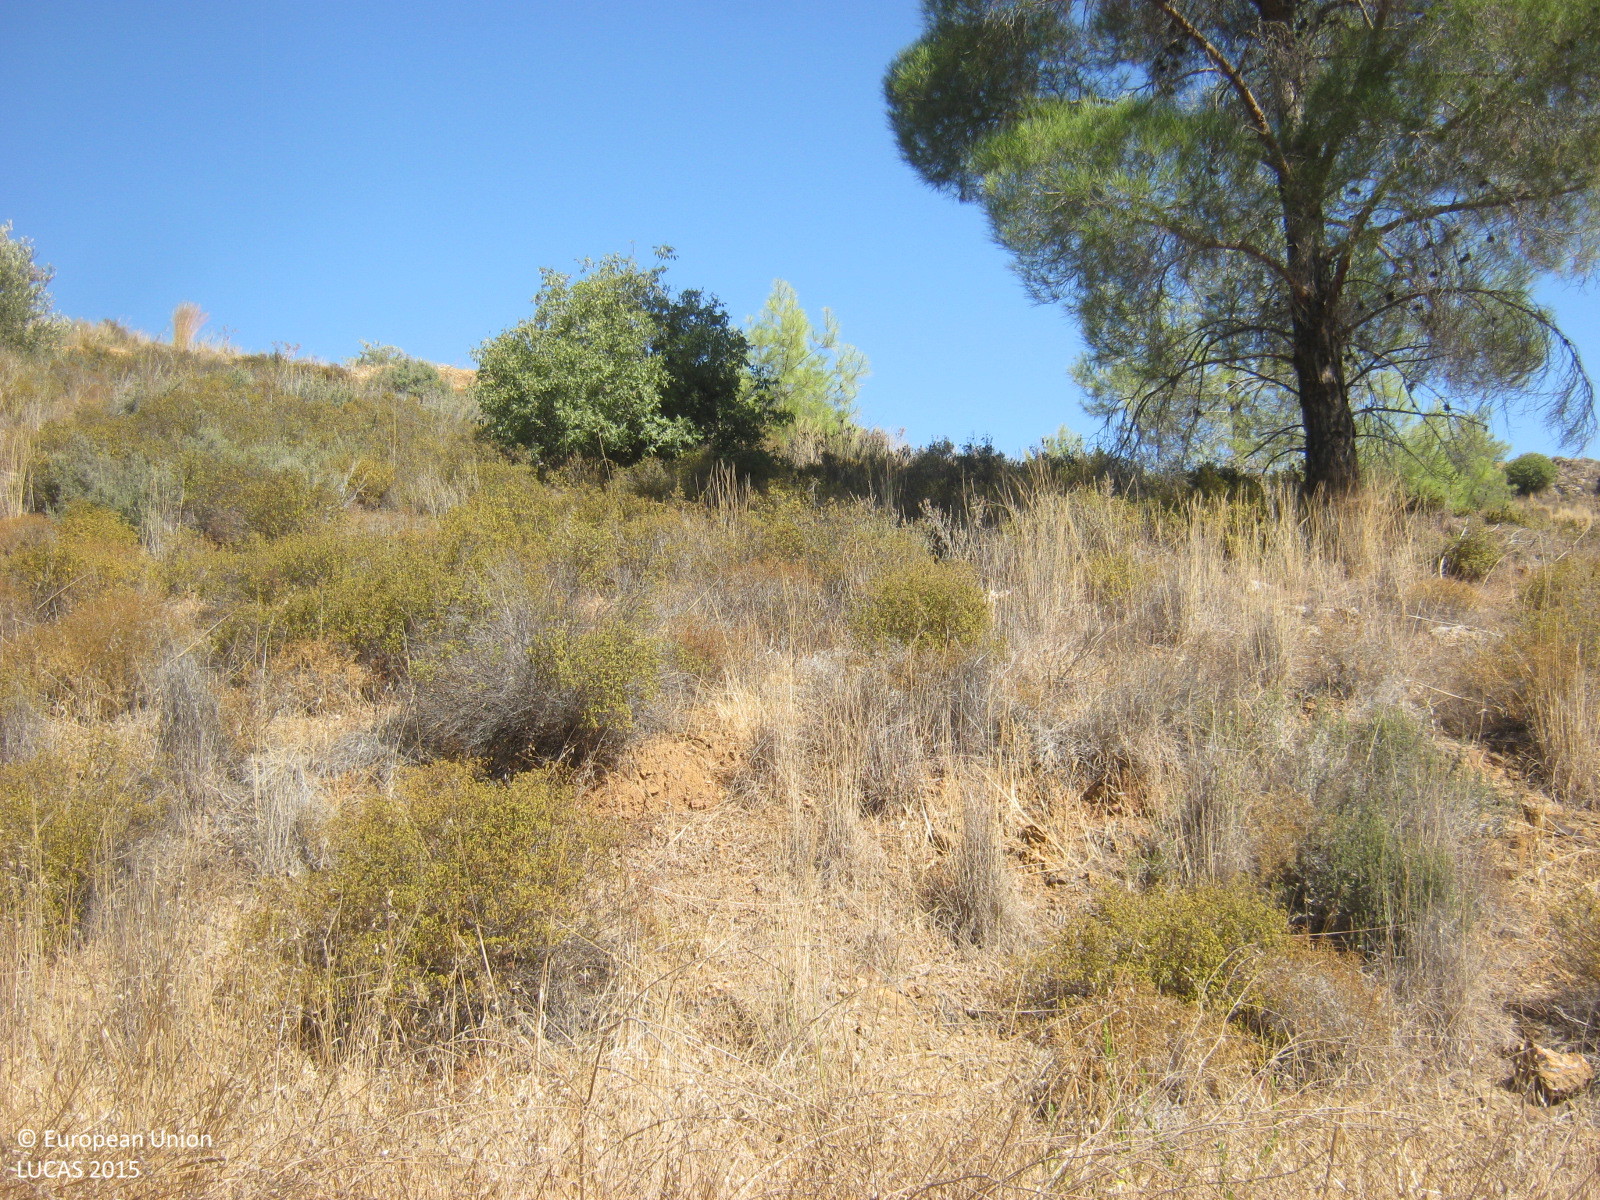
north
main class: Shrubland
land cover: Shrubland without tree cover
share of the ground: 50 - 75 %
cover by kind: shrubs 50 %, unconsolidated bare surface 30 %, herbaceous plants 20 %
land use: Semi-natural and natural areas not in use
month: April
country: CY
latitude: 34.9435
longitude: 33.3661
